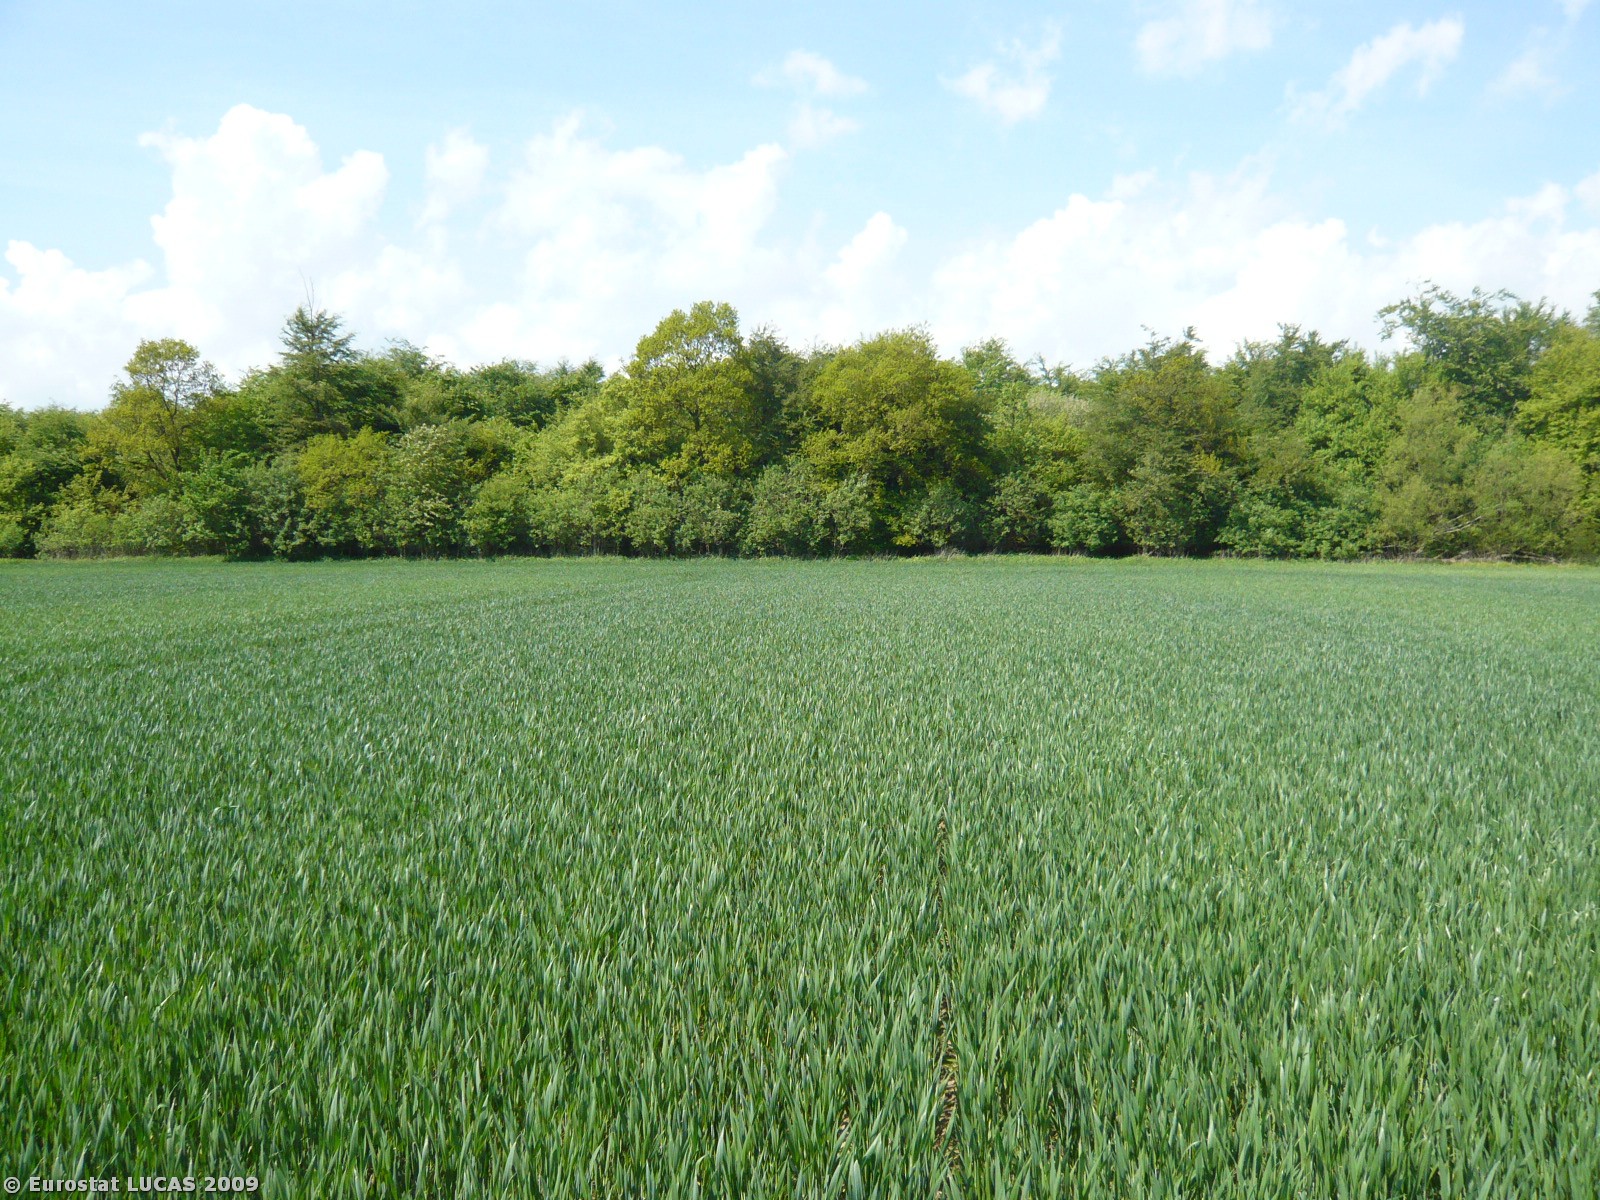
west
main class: Cropland
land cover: Common wheat
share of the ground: > 75 %
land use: Agriculture (excluding fallow land and kitchen gardens)
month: May
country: DK
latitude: 55.3060
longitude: 12.1881
